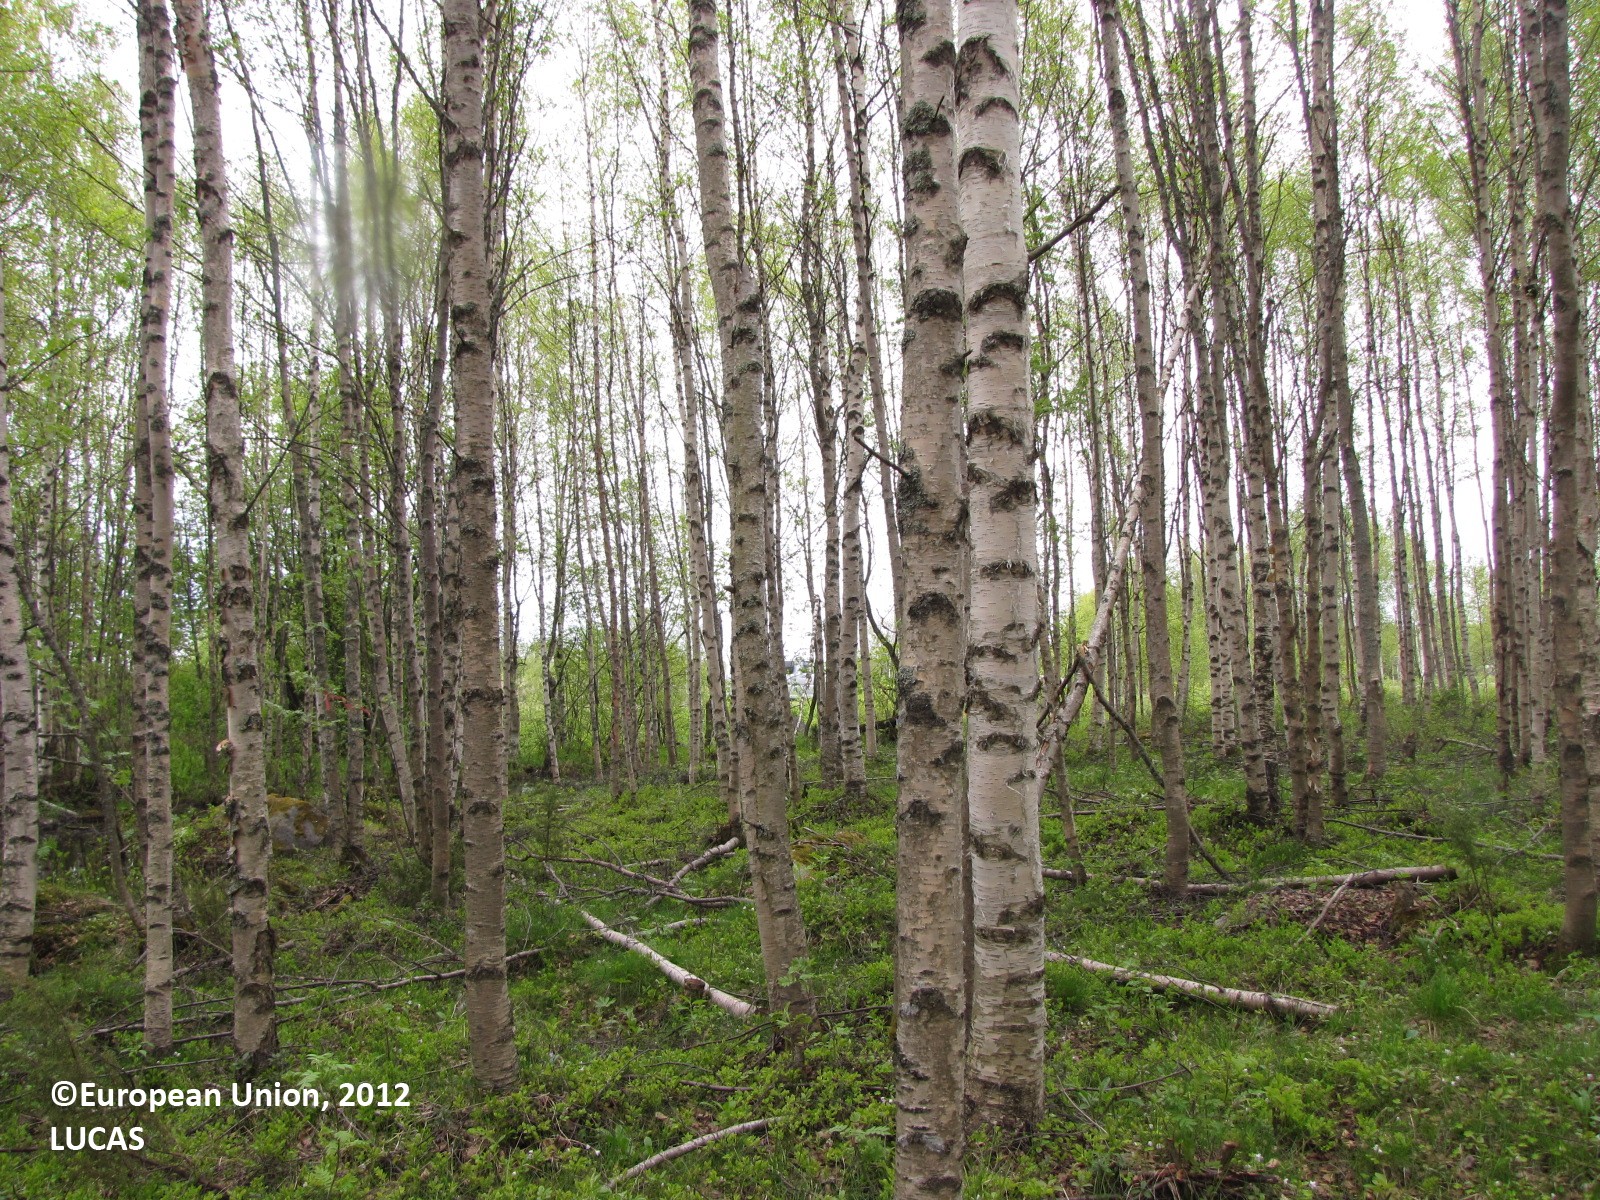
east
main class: Woodland
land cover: Broadleaved woodland
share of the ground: > 75 %
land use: Forestry
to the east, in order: Broadleaved woodland; Grass margins; Paved roads, cycling and walking lanes; Grass margins; Ditches and canals; Spontaneously vegetated surfaces; Electric lines; Paved roads, cycling and walking lanes; Grass margins; Ditches and canals; Broadleaved woodland; Spontaneously vegetated surfaces; Other mixed woodland; Tracks; Broadleaved woodland
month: June
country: FI
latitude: 65.8369
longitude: 24.2134
